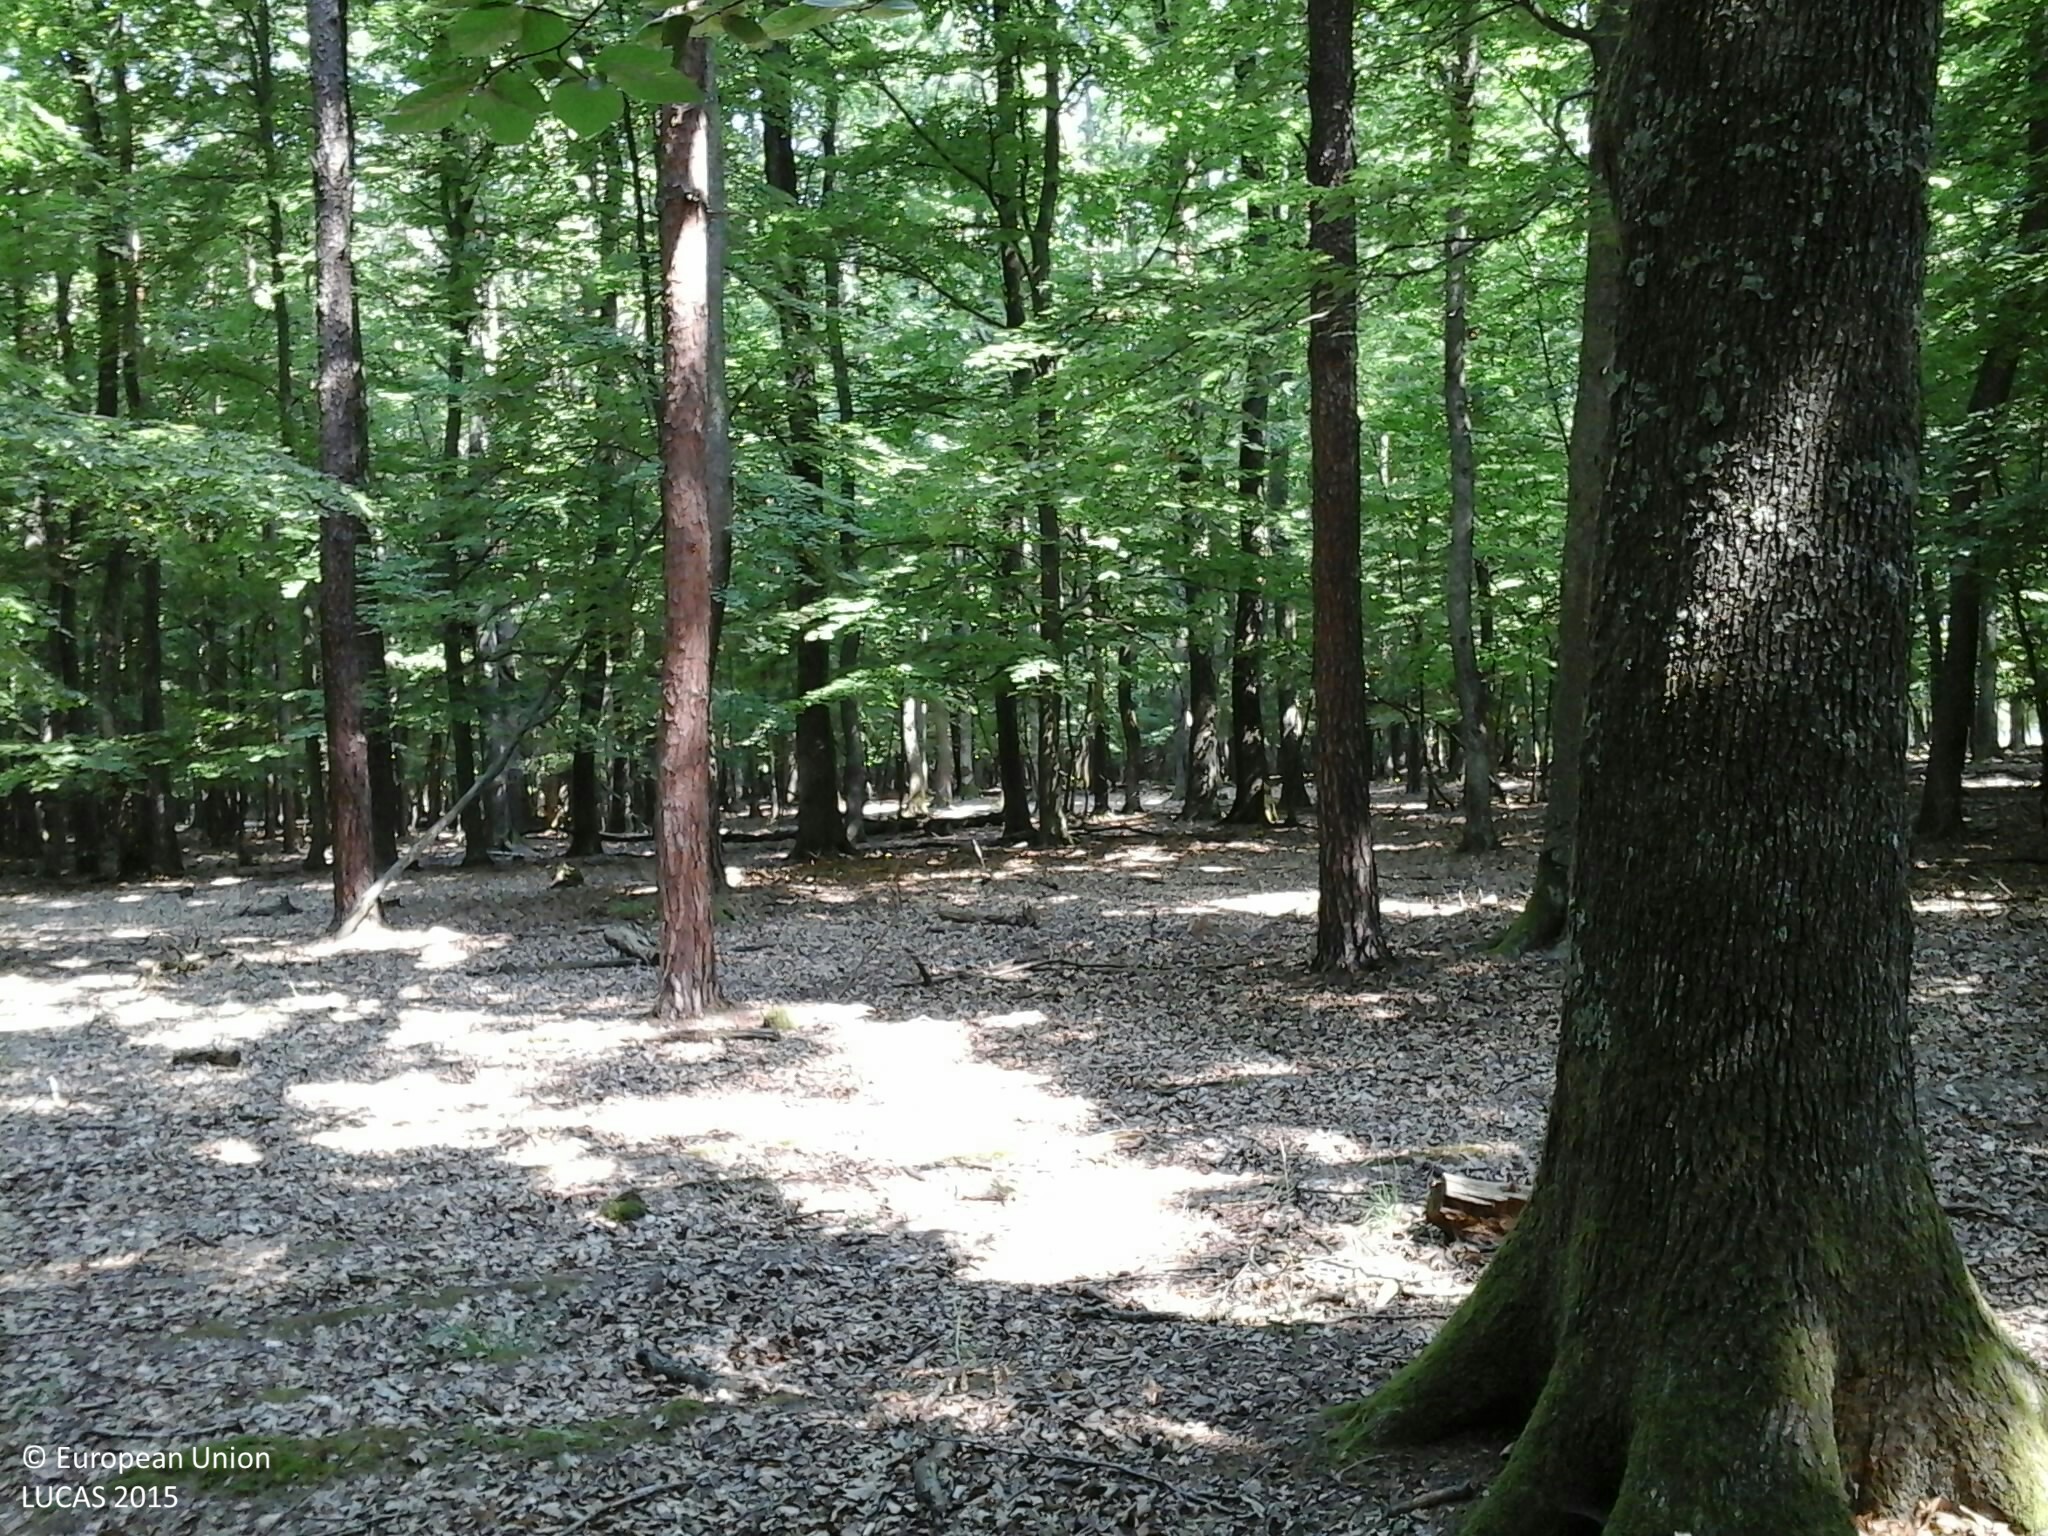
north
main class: Woodland
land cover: Broadleaved woodland
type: mesophytic deciduous forest
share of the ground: > 75 %
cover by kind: broadleaved forest trees 90 %, coniferous forest trees 10 %
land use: Forestry
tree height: > 5 m
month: July
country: HU
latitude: 46.6711
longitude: 16.6029
